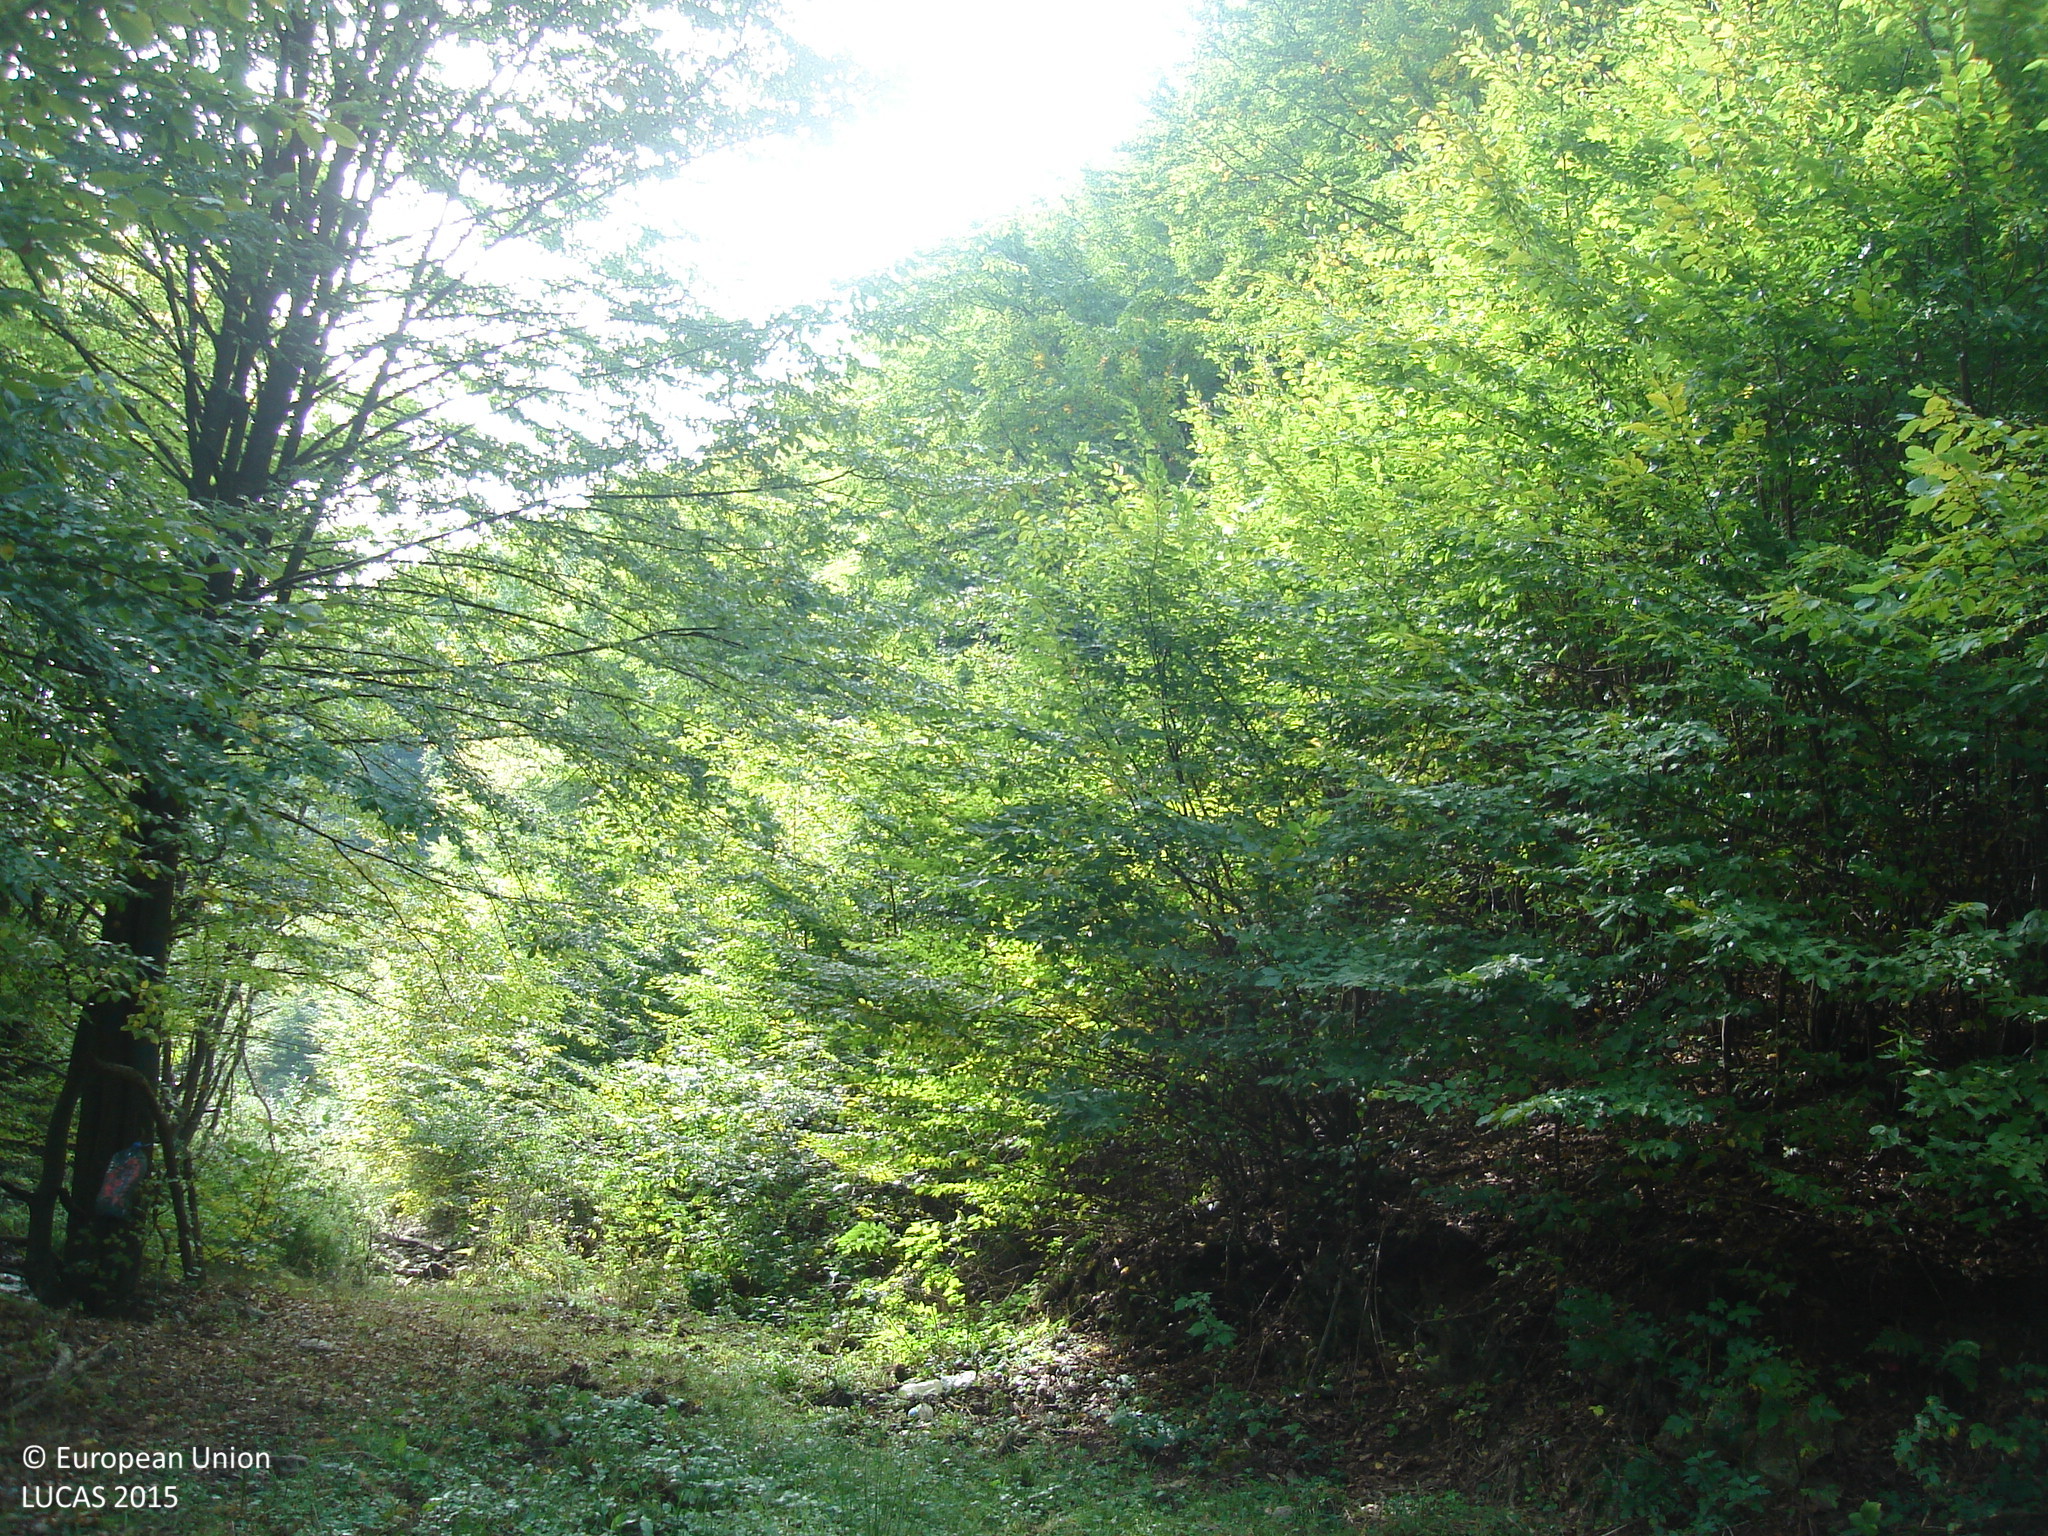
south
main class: Woodland
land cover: Broadleaved woodland
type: mesophytic deciduous forest
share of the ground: > 75 %
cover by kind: broadleaved forest trees 100 %
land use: Forestry
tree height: > 5 m
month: October
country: BG
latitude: 42.5795
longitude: 23.8207
